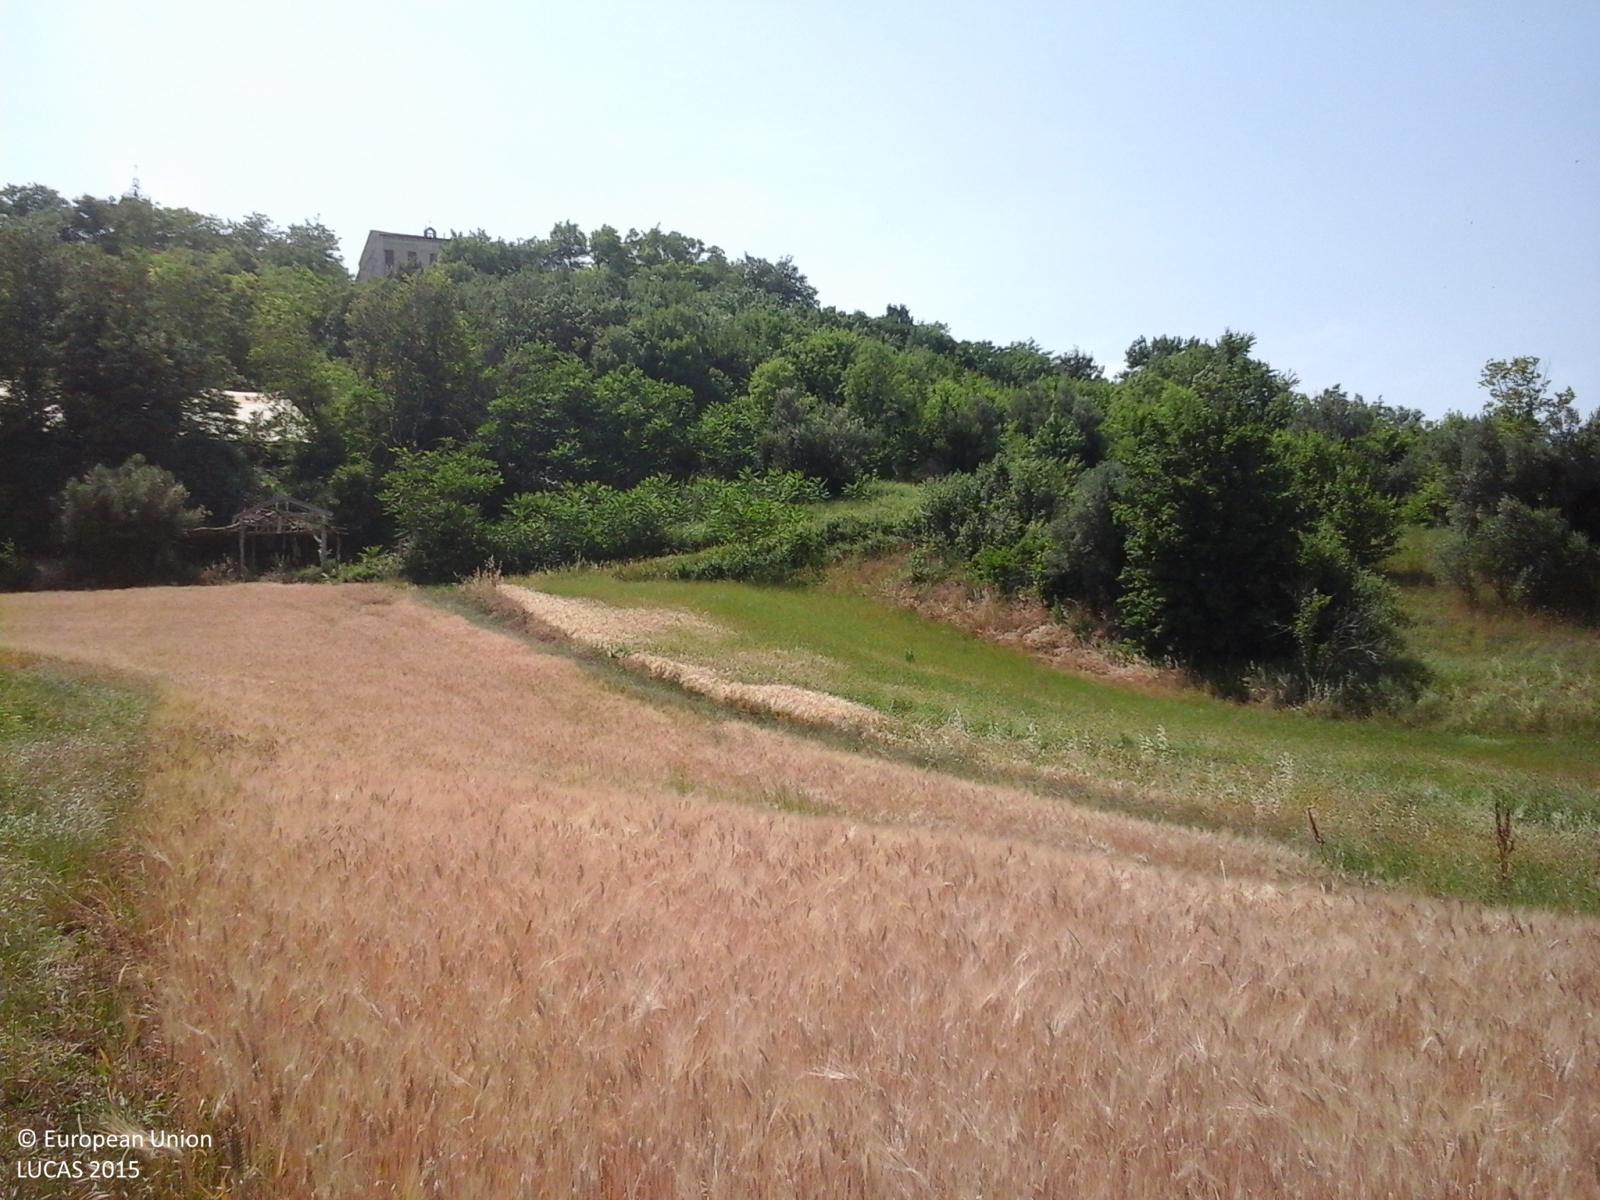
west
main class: Cropland
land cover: Olive groves
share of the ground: 25 - 50 %
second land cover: Spontaneously vegetated surfaces
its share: 25 - 50 %
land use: Agriculture (excluding fallow land and kitchen gardens)
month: June
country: IT
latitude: 42.1985
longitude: 14.3584
